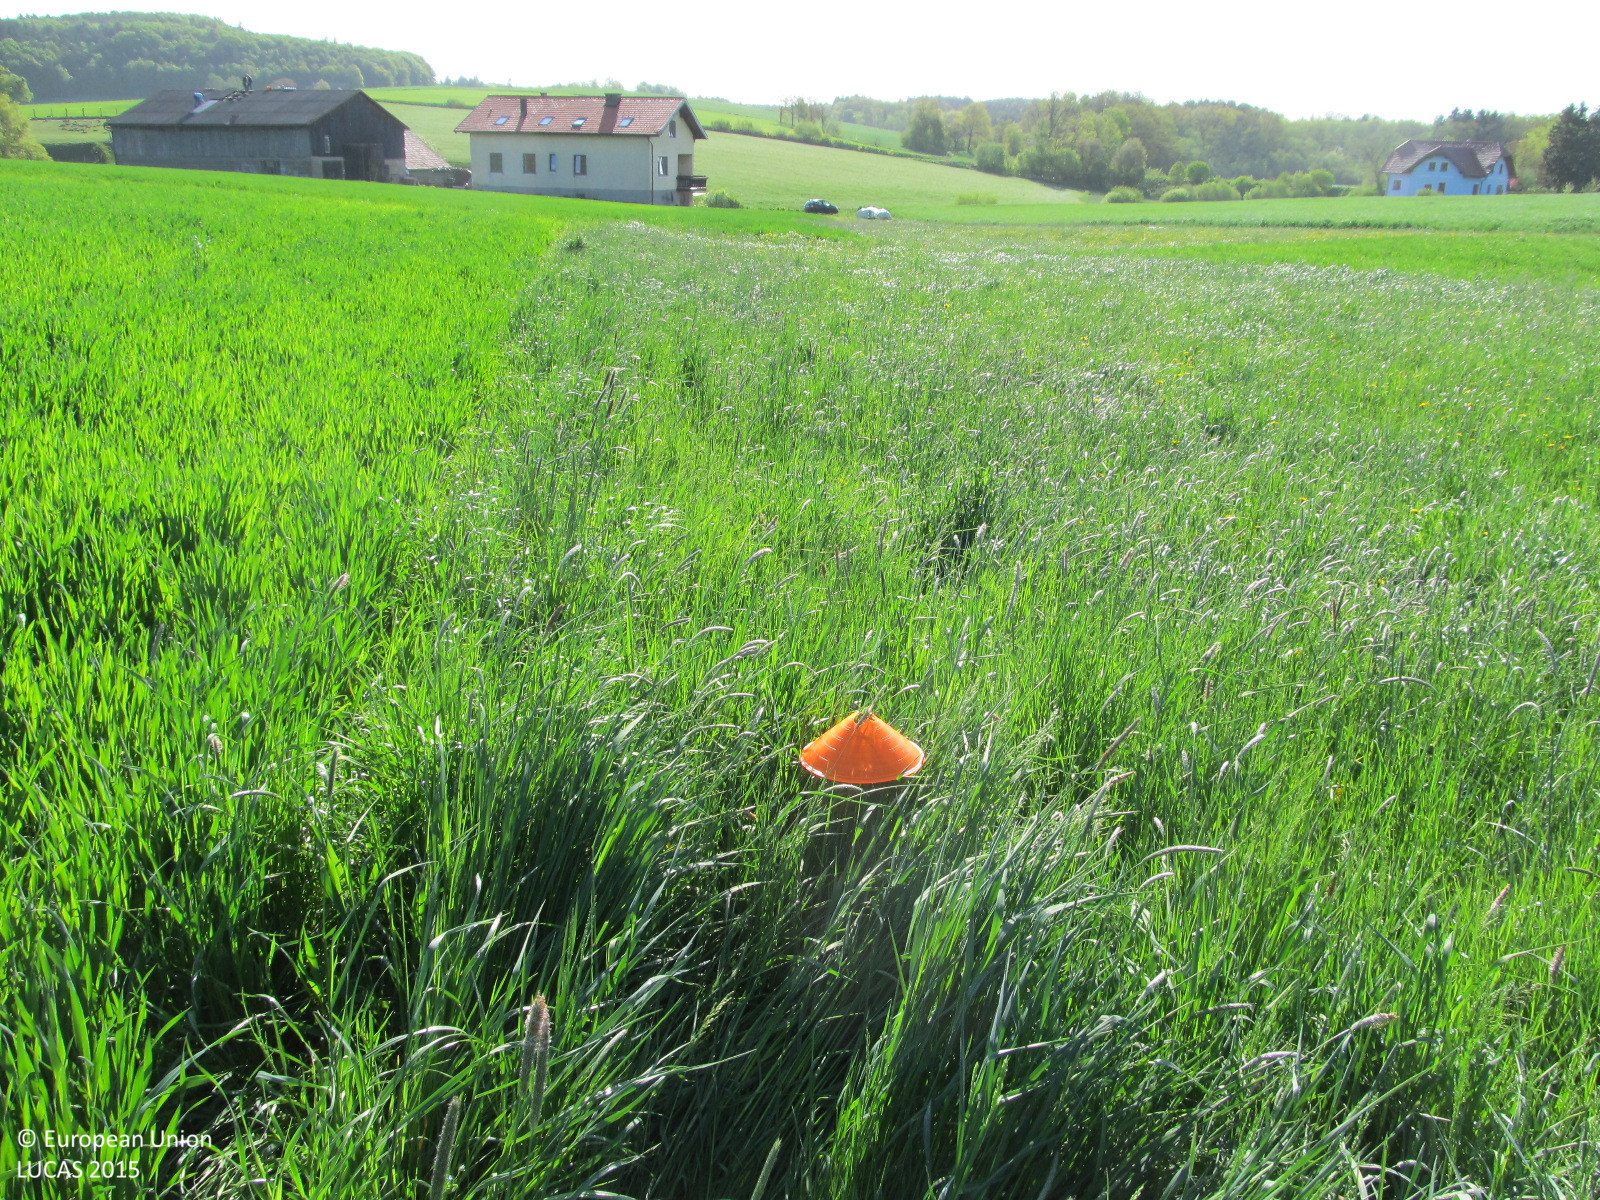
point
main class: Grassland
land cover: Grassland without tree/shrub cover
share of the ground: > 75 %
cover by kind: herbaceous plants 100 %
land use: Agriculture (excluding fallow land and kitchen gardens)
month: May
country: AT
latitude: 48.5377
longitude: 15.4880
